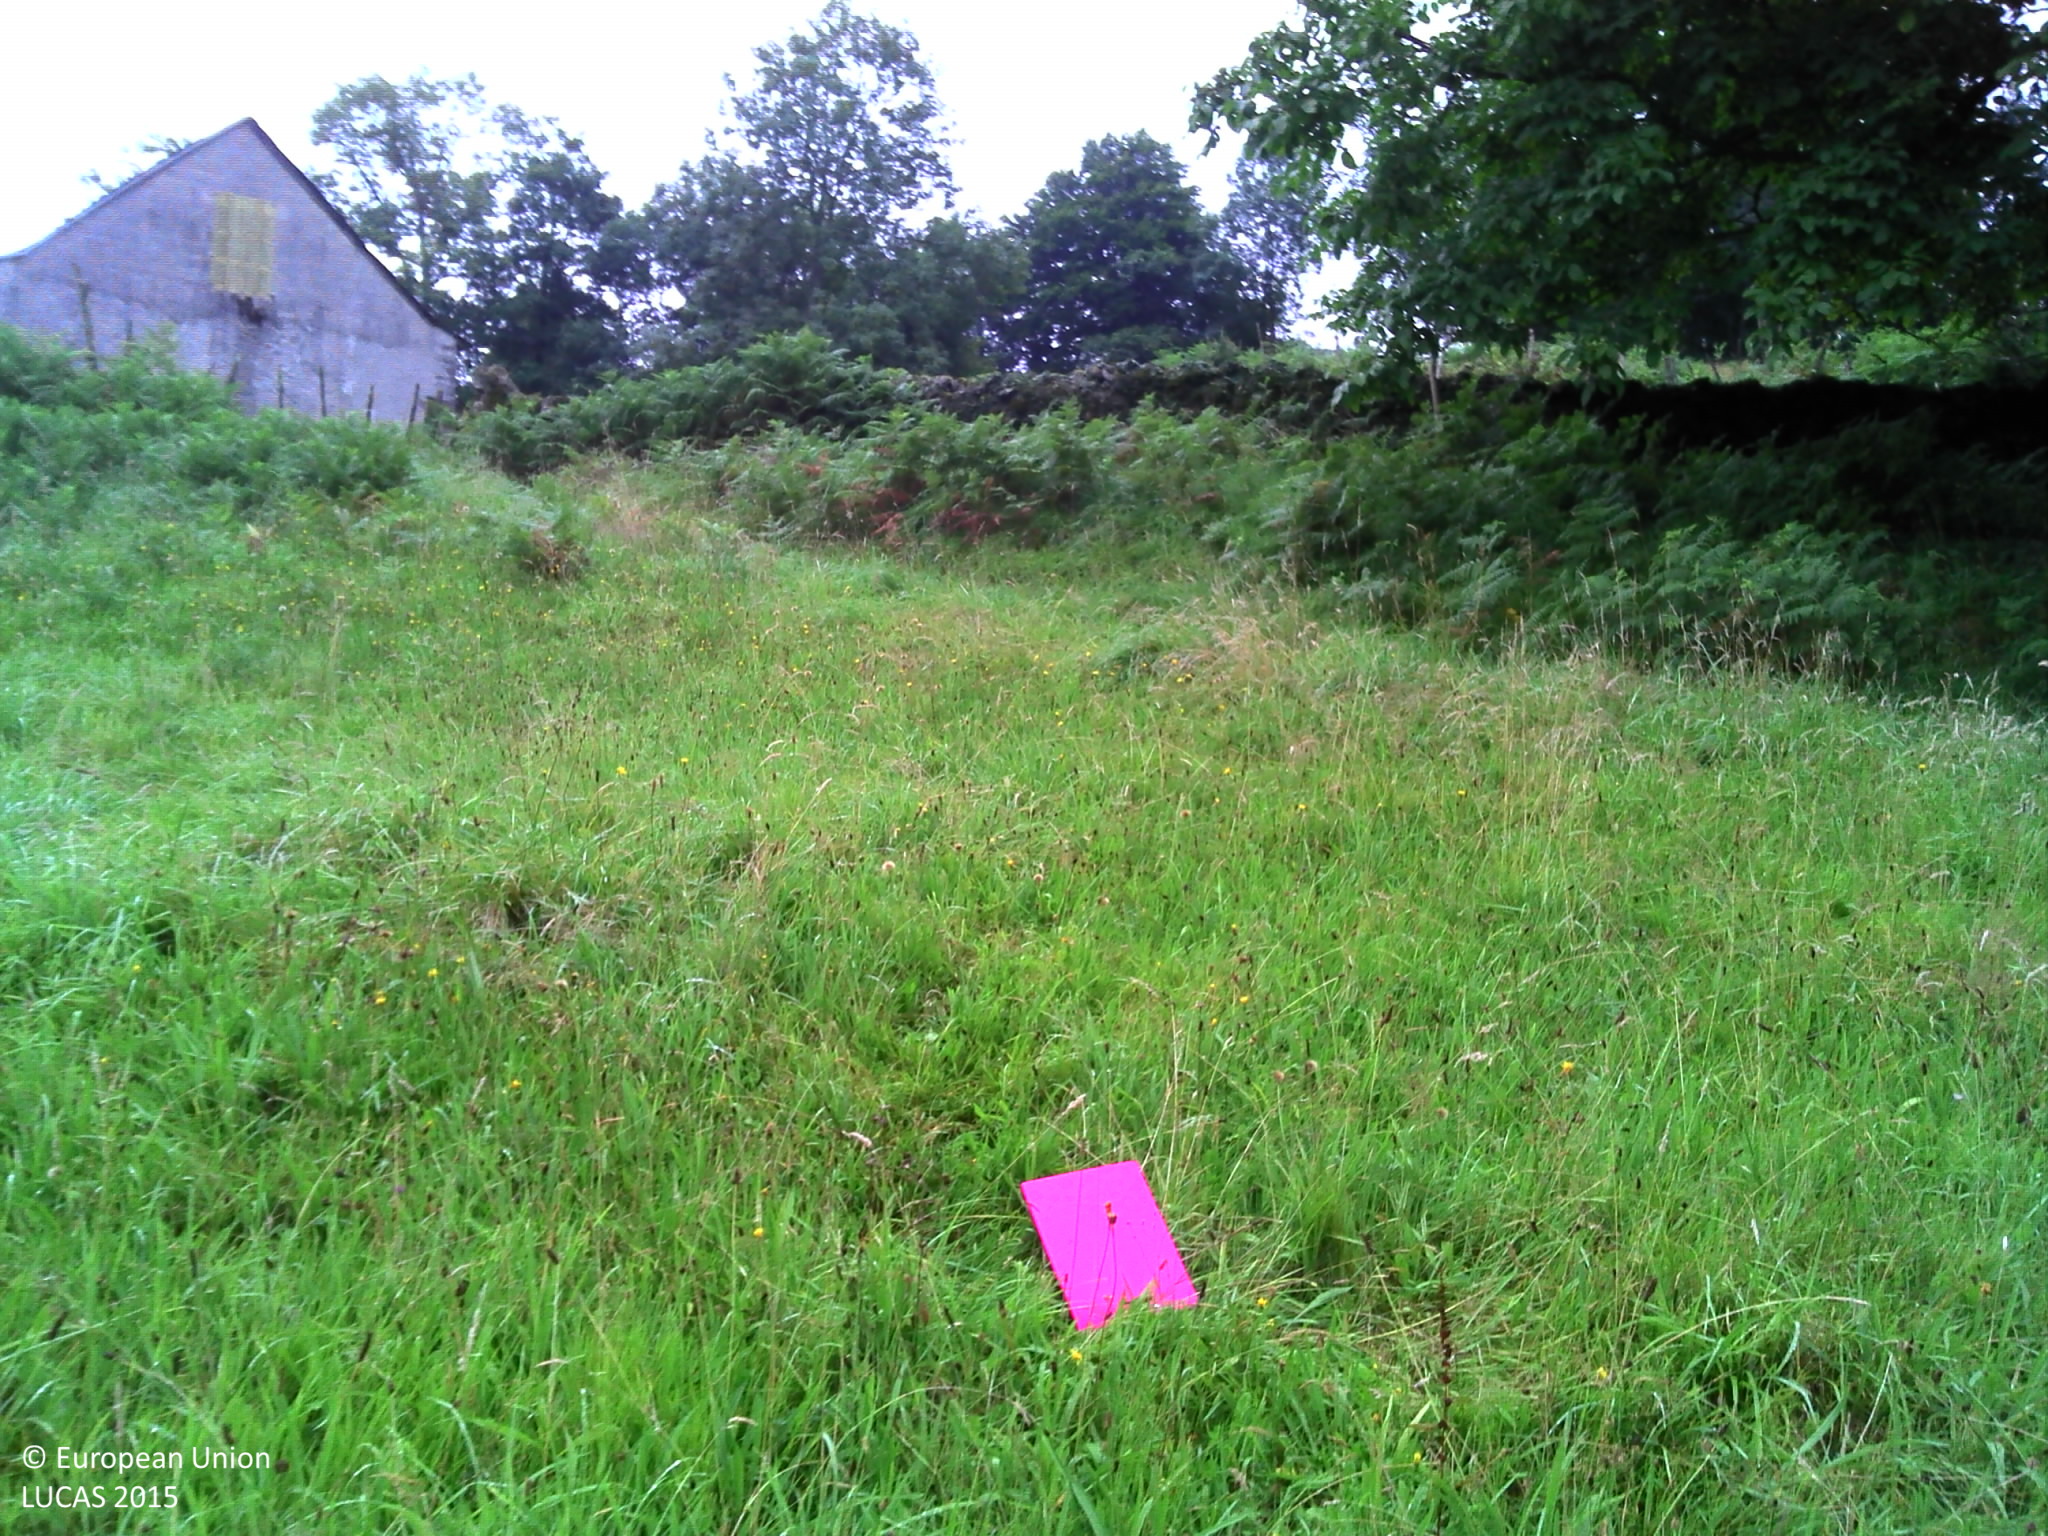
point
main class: Grassland
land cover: Grassland without tree/shrub cover
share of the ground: > 75 %
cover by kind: herbaceous plants 100 %
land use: Agriculture (excluding fallow land and kitchen gardens)
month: July
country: FR
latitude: 43.1210
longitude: -0.3667
